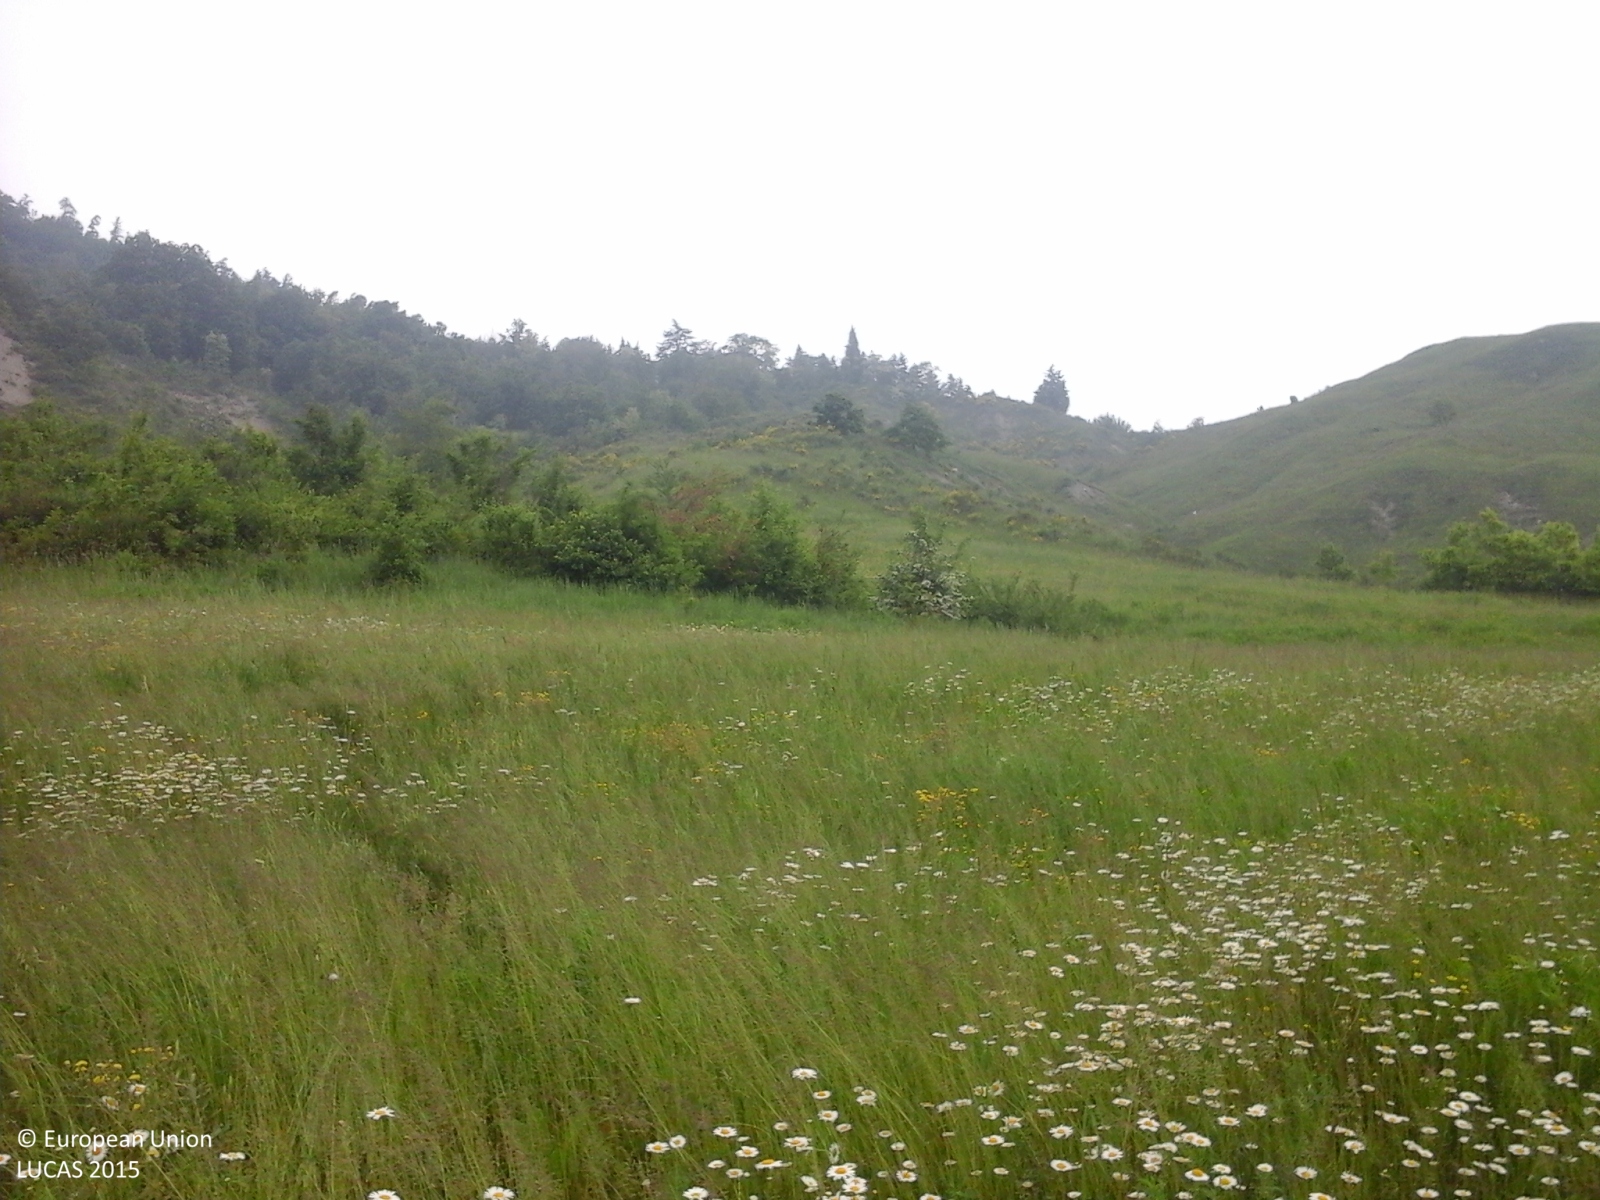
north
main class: Cropland
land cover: Lucerne
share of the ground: 50 - 75 %
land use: Agriculture (excluding fallow land and kitchen gardens)
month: May
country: IT
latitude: 44.3812
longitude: 11.0645
